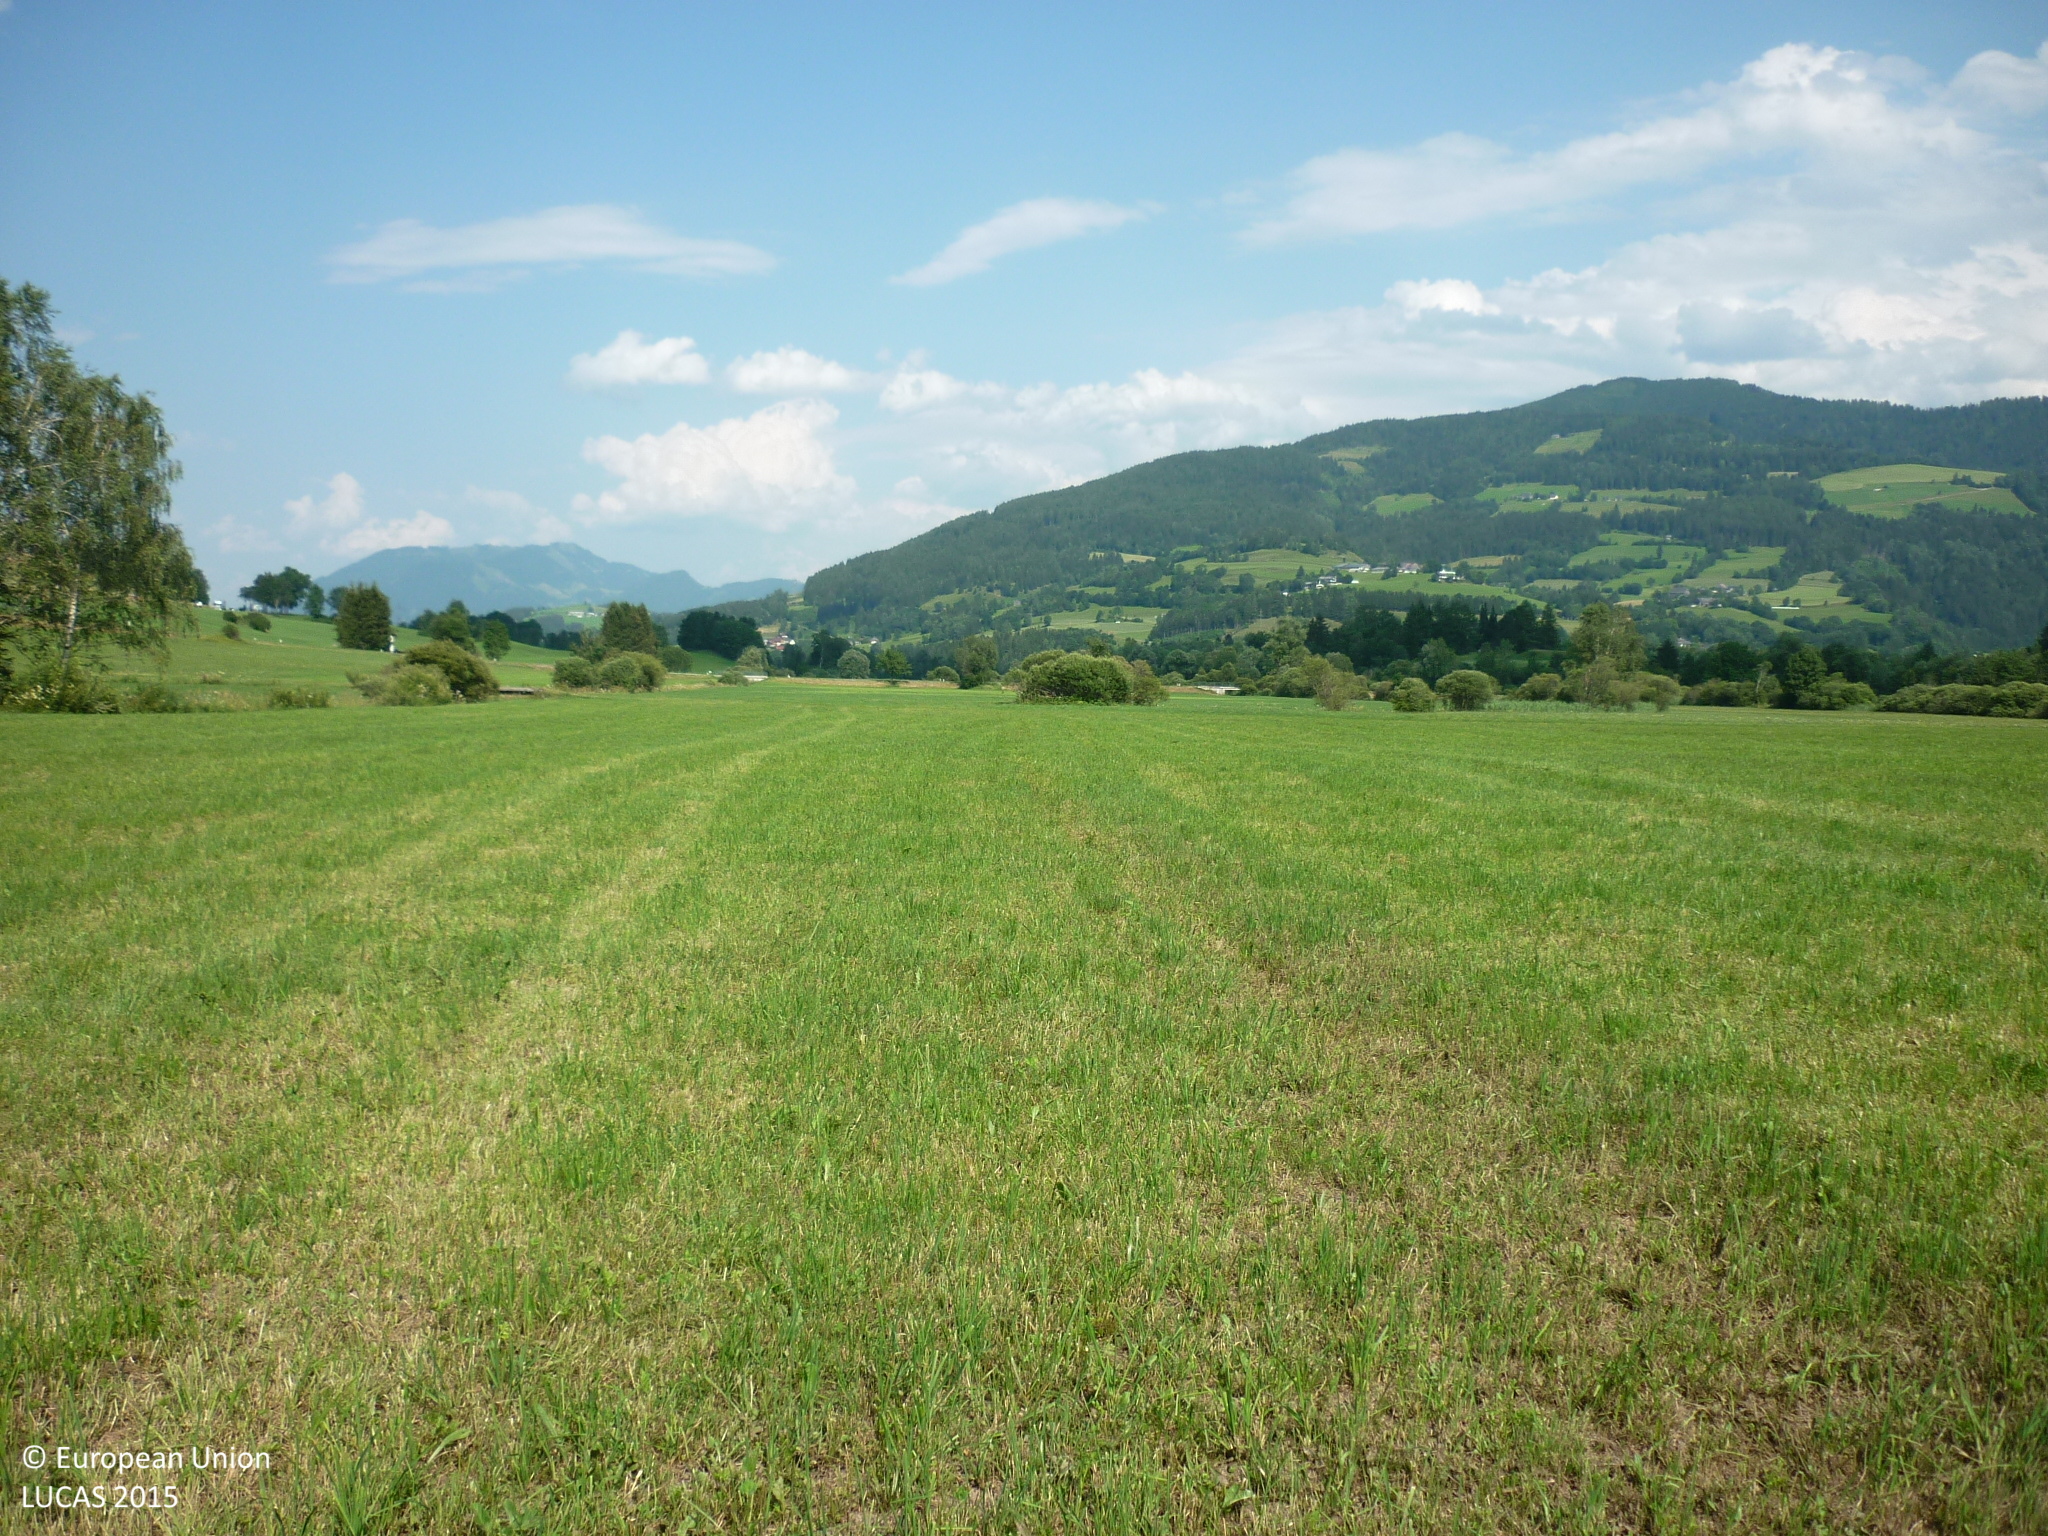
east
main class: Grassland
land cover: Grassland without tree/shrub cover
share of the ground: > 75 %
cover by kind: herbaceous plants 100 %
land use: Agriculture (excluding fallow land and kitchen gardens)
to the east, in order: Grassland without tree/shrub cover; Single bushes/trees; Grassland without tree/shrub cover
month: July
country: AT
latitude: 47.4845
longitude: 13.9933
